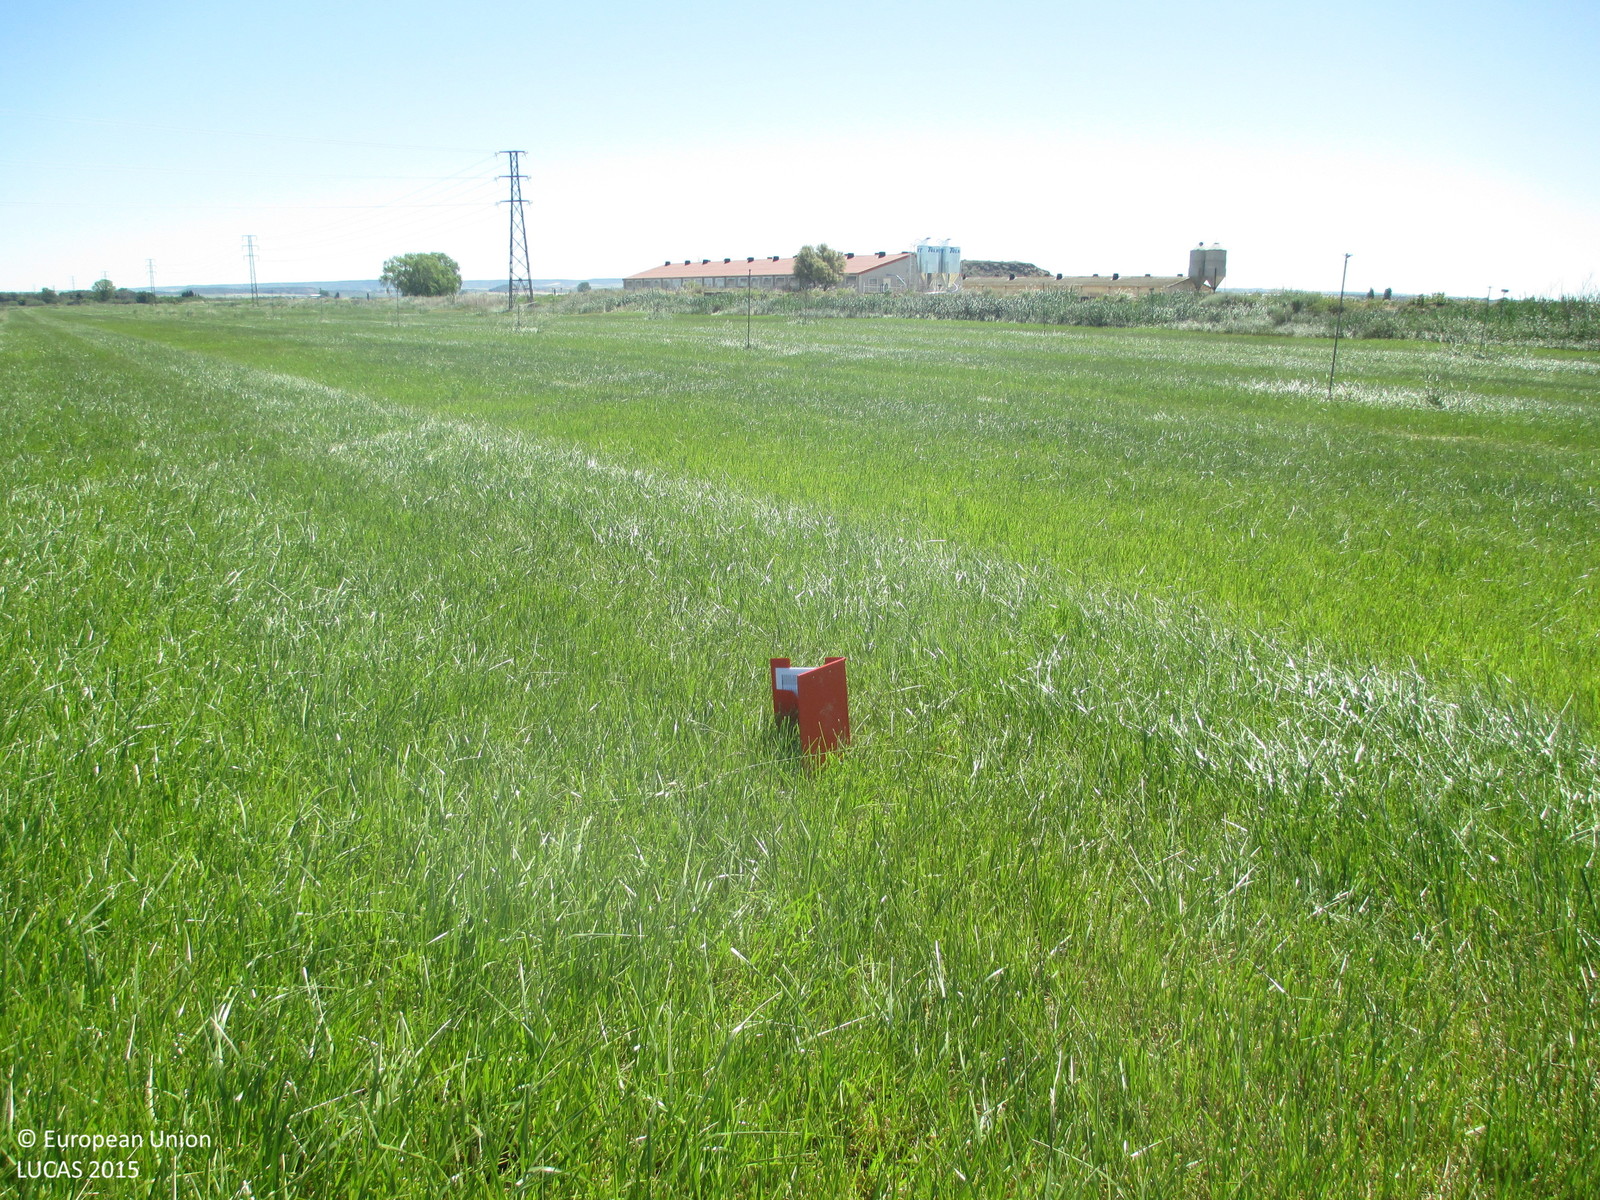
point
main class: Cropland
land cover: Temporary grasslands
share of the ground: > 75 %
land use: Agriculture (excluding fallow land and kitchen gardens)
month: May
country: ES
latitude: 41.8626
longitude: -0.2227
